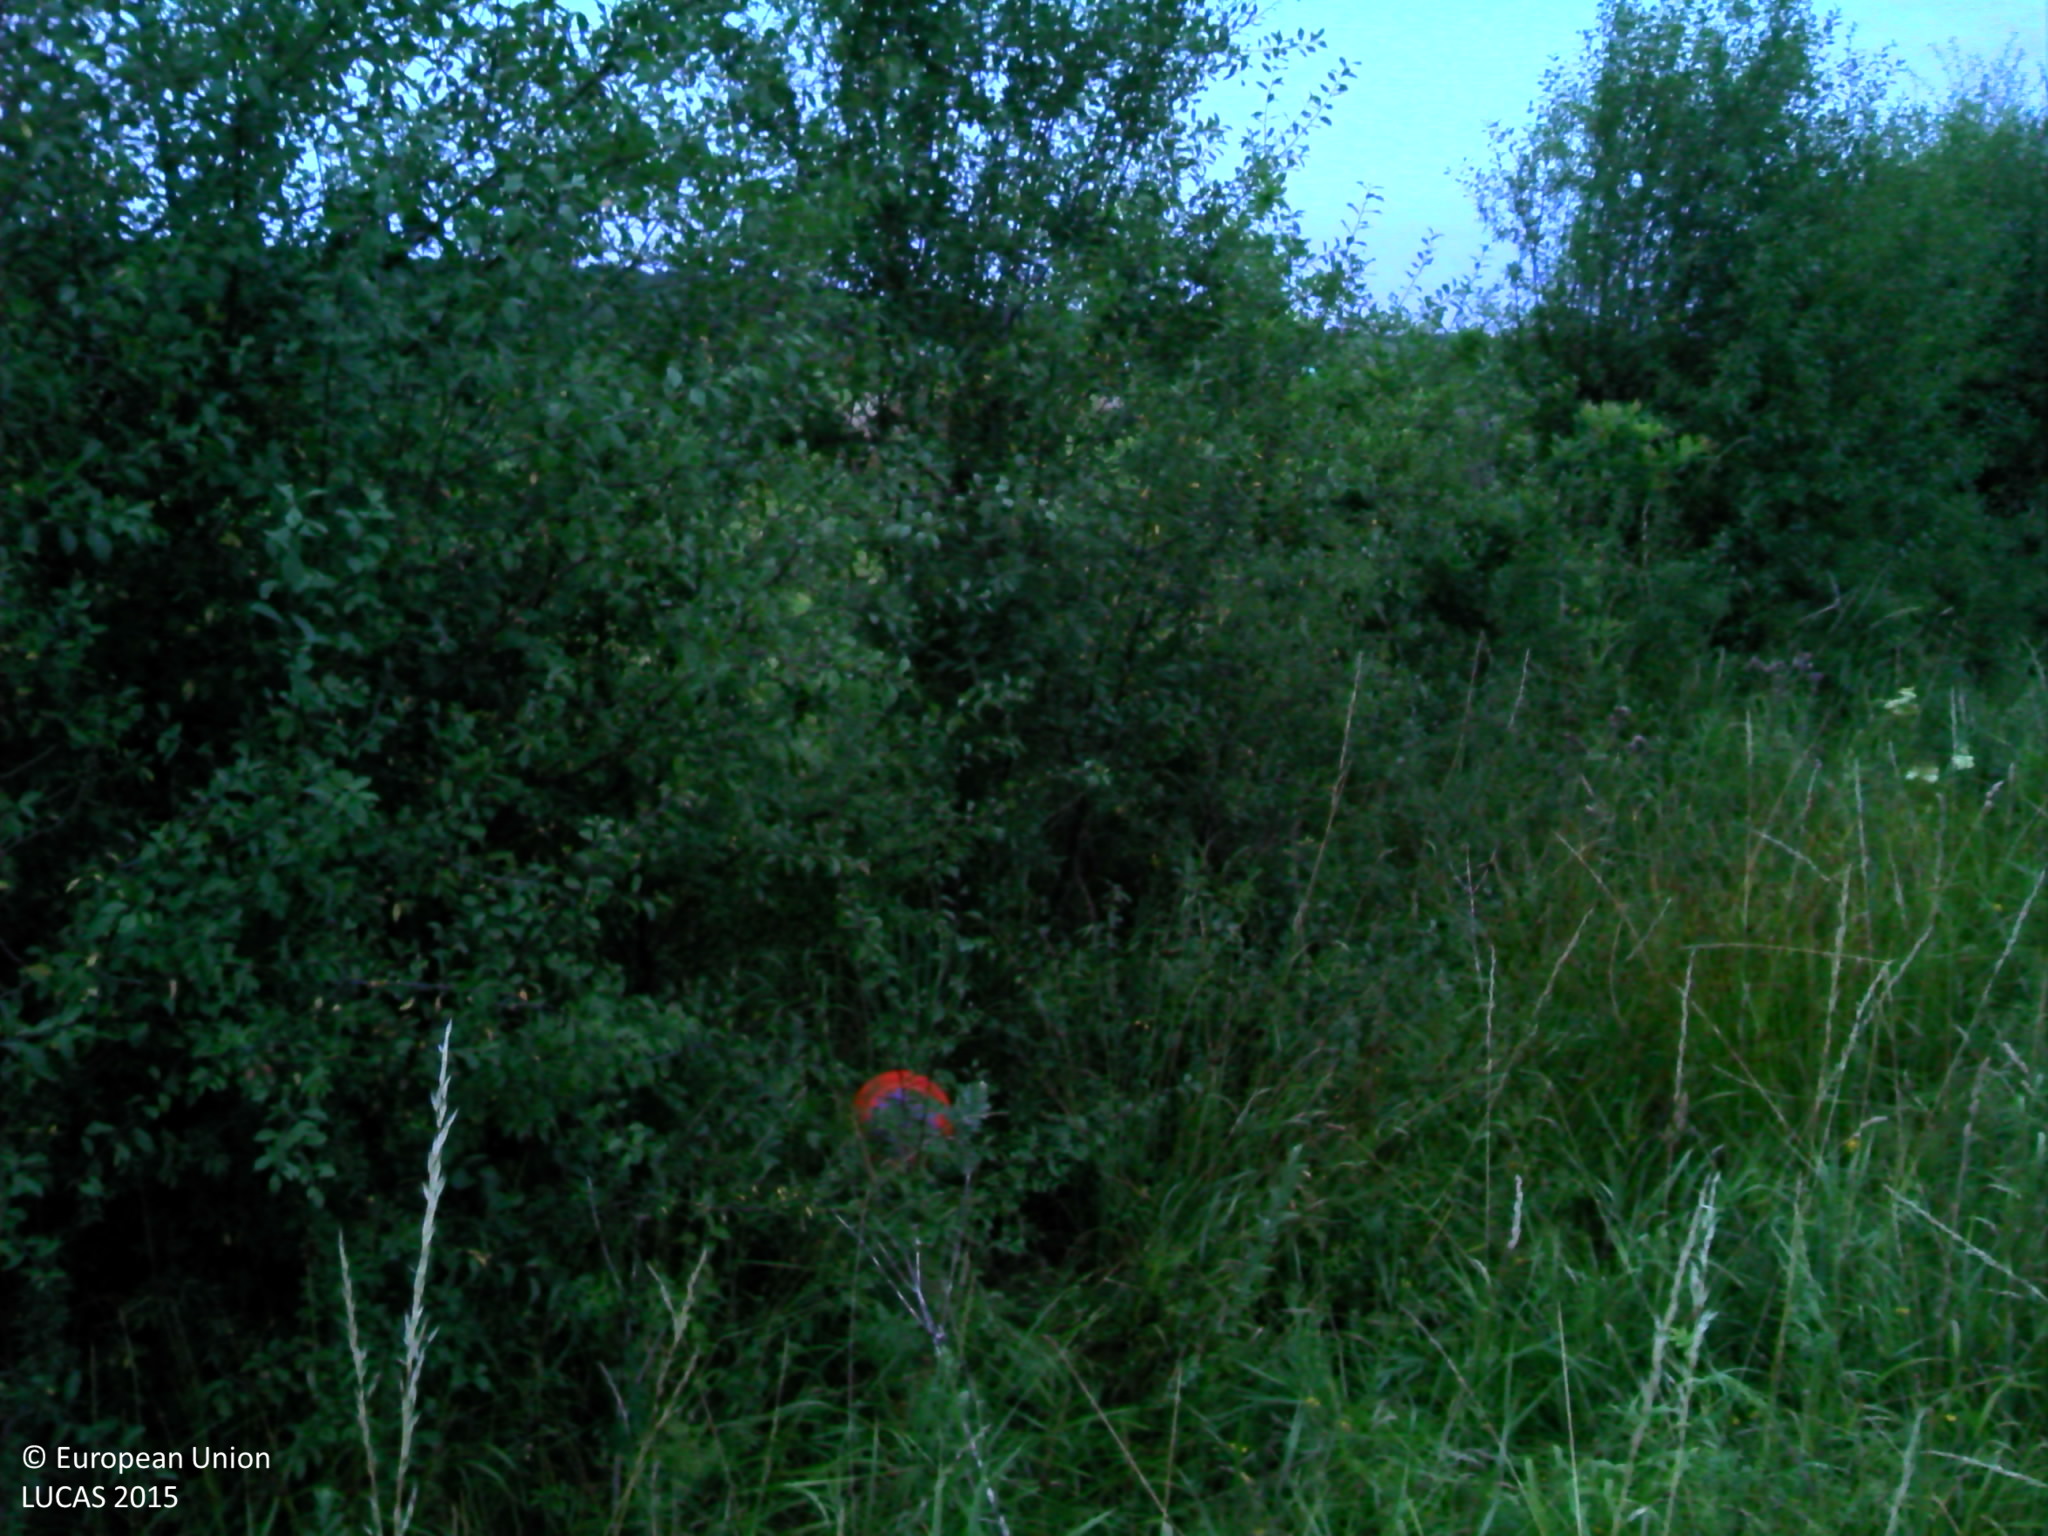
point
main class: Grassland
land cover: Grassland without tree/shrub cover
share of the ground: > 75 %
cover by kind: herbaceous plants 100 %
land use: Agriculture (excluding fallow land and kitchen gardens)
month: July
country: BE
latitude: 49.7124
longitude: 5.3801
